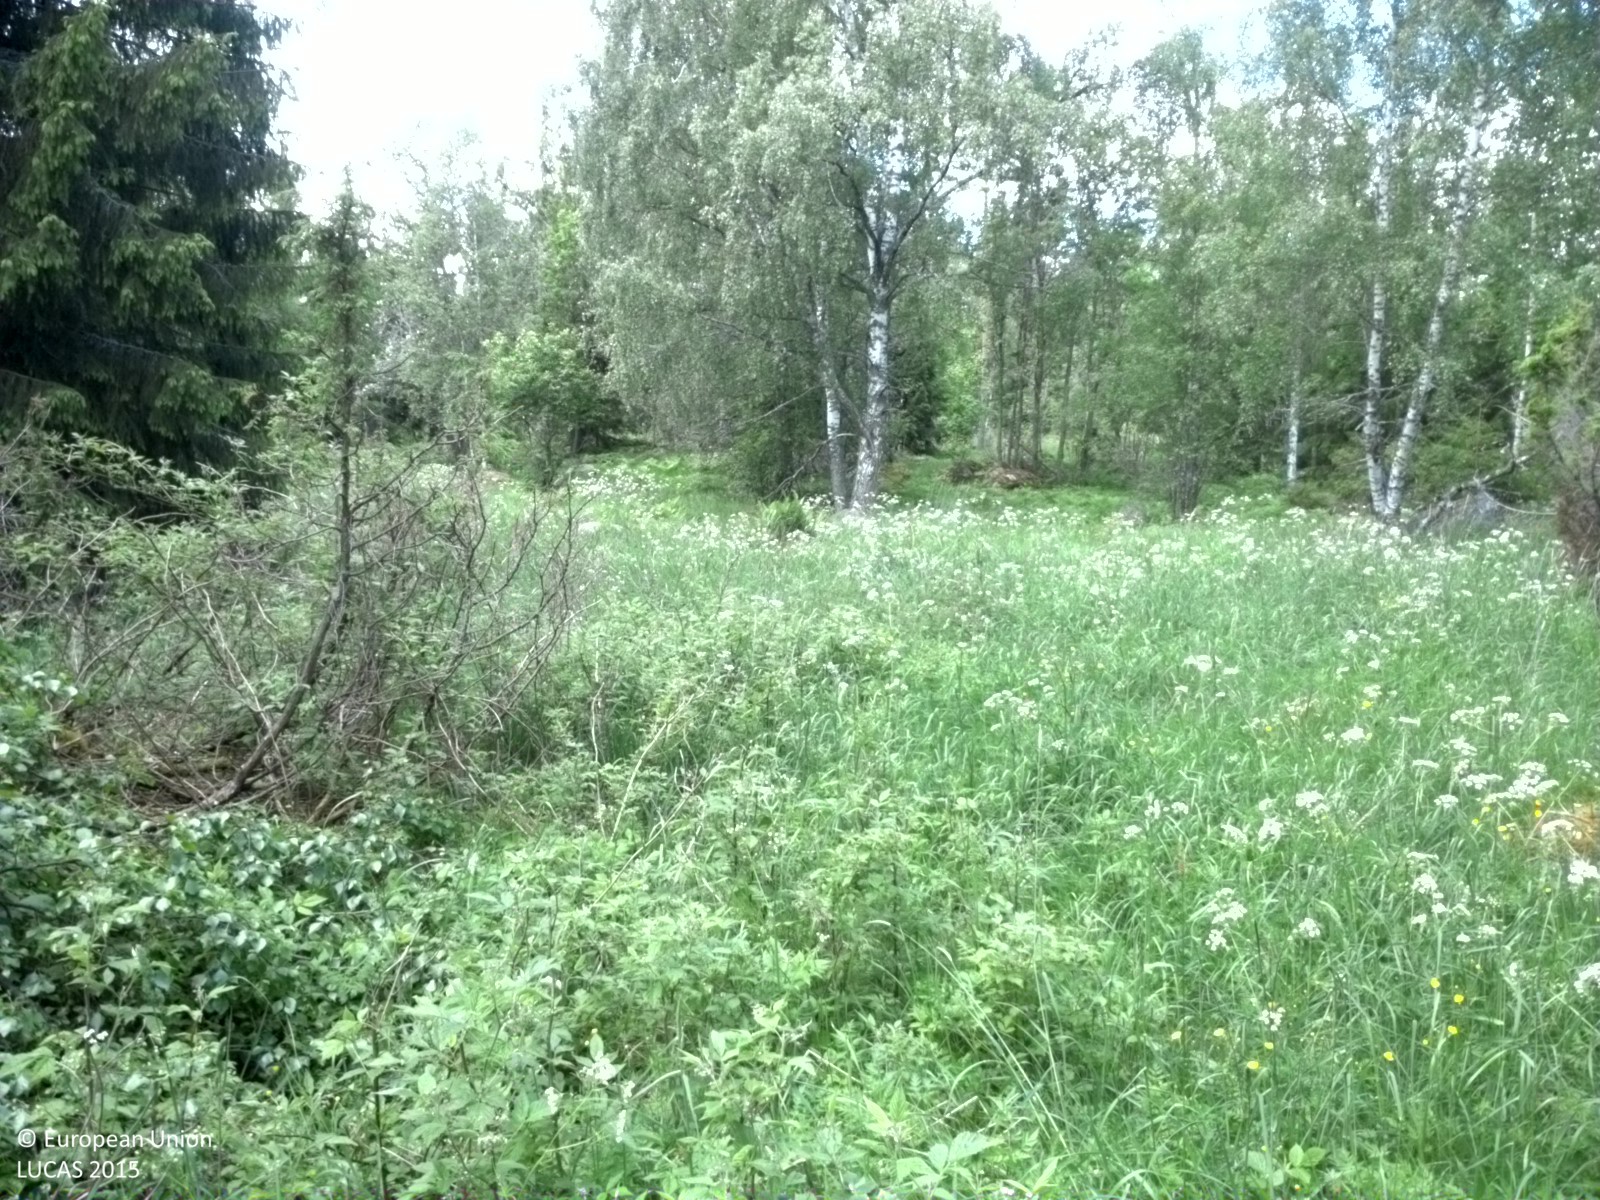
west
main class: Grassland
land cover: Grassland with sparse tree/shrub cover
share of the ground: > 75 %
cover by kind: herbaceous plants 90 %, broadleaved forest trees 5 %, shrubs 5 %
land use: Agriculture (excluding fallow land and kitchen gardens)
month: June
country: SE
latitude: 60.1838
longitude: 17.7644
